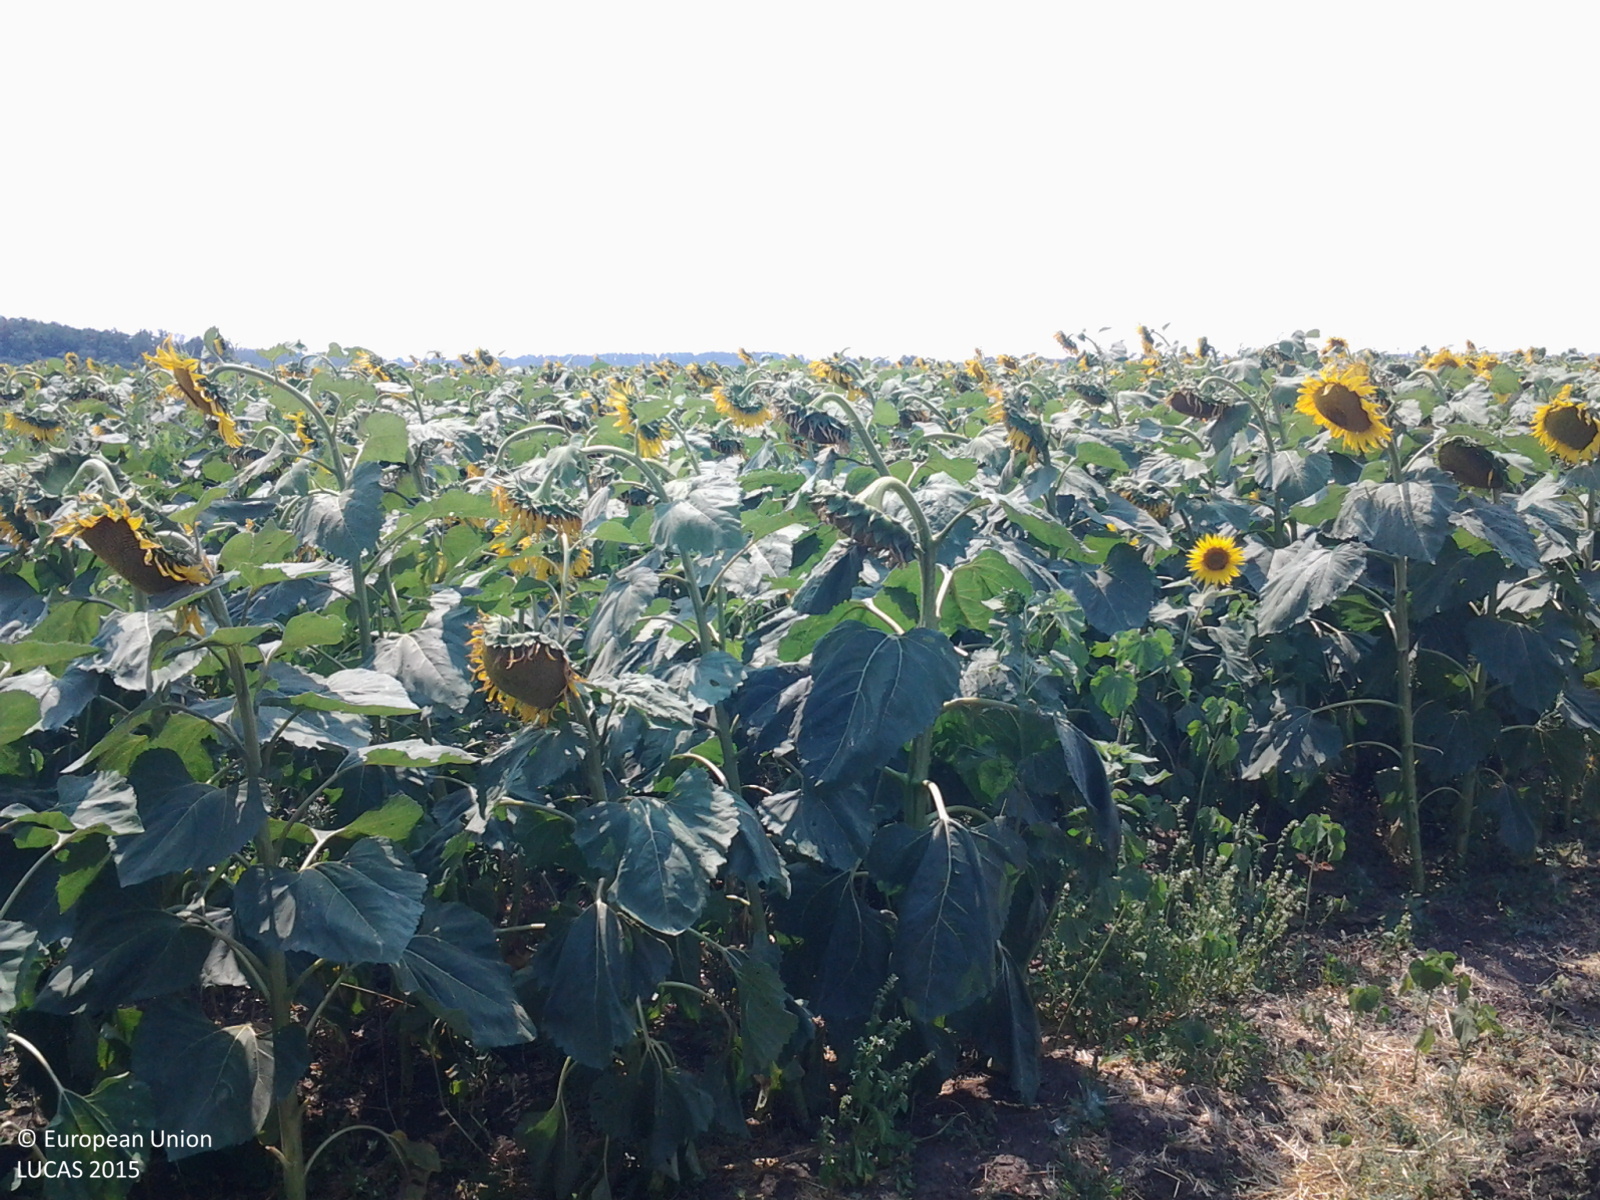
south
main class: Cropland
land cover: Common wheat
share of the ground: < 10 %
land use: Agriculture (excluding fallow land and kitchen gardens)
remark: Tilled/Sowed
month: July
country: HU
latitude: 47.1414
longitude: 20.4857
